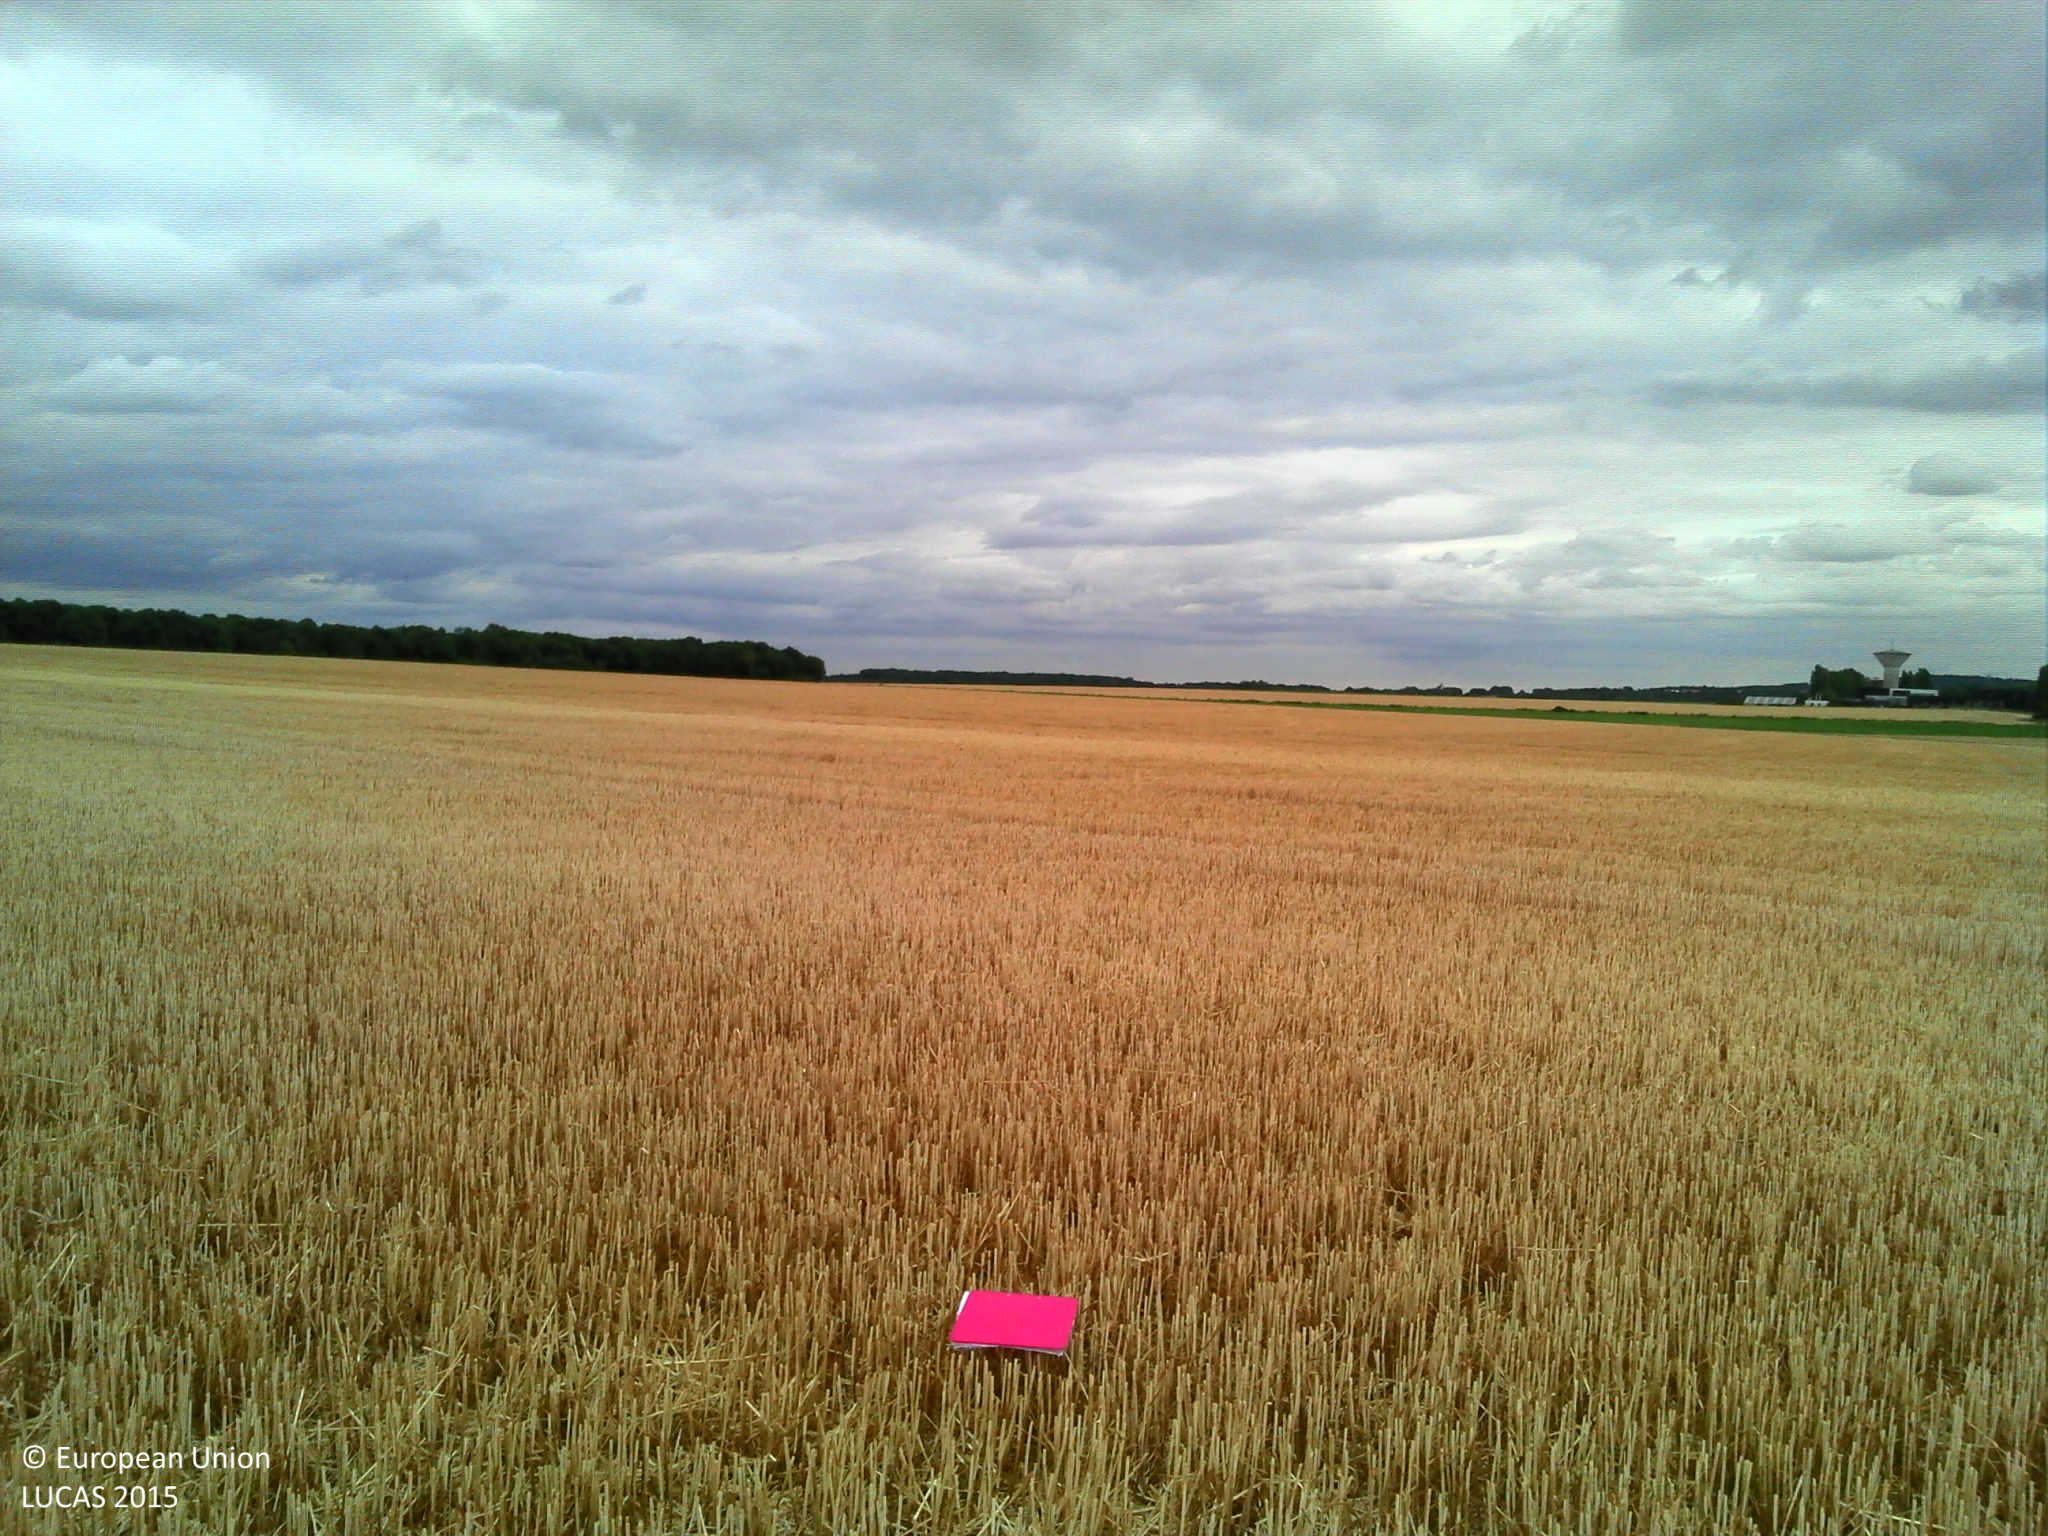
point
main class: Cropland
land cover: Common wheat
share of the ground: > 75 %
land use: Agriculture (excluding fallow land and kitchen gardens)
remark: Harvested field
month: July
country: FR
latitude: 49.1059
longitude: 2.4956
